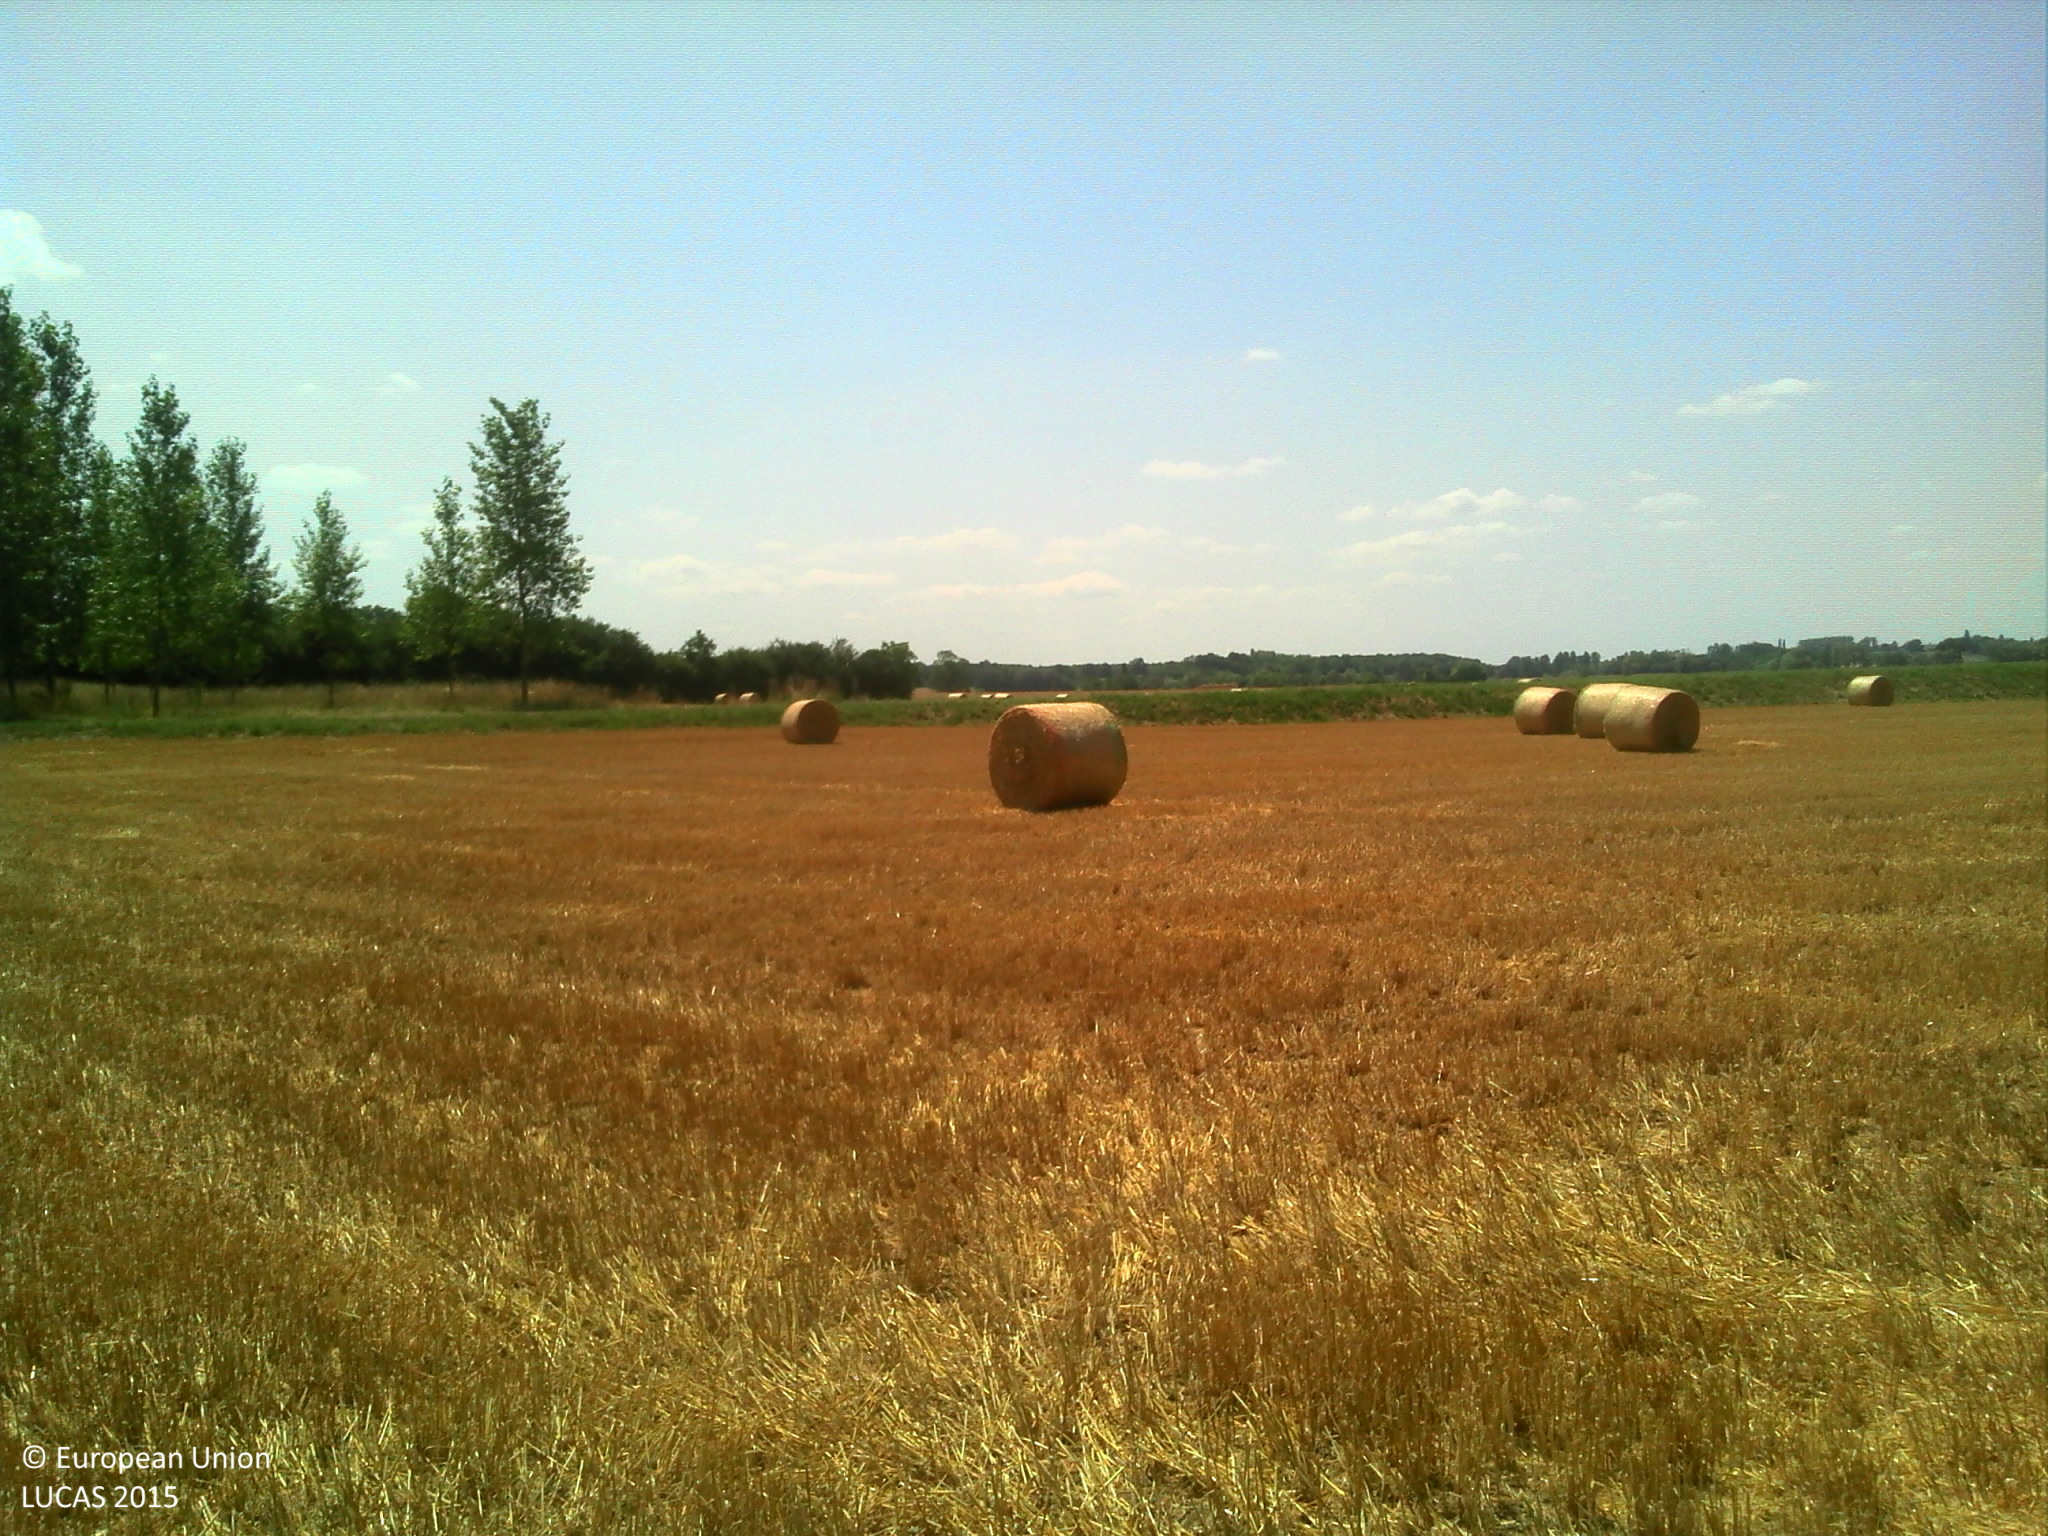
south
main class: Cropland
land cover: Common wheat
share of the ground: > 75 %
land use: Agriculture (excluding fallow land and kitchen gardens)
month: July
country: FR
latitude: 46.9246
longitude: 5.1029
